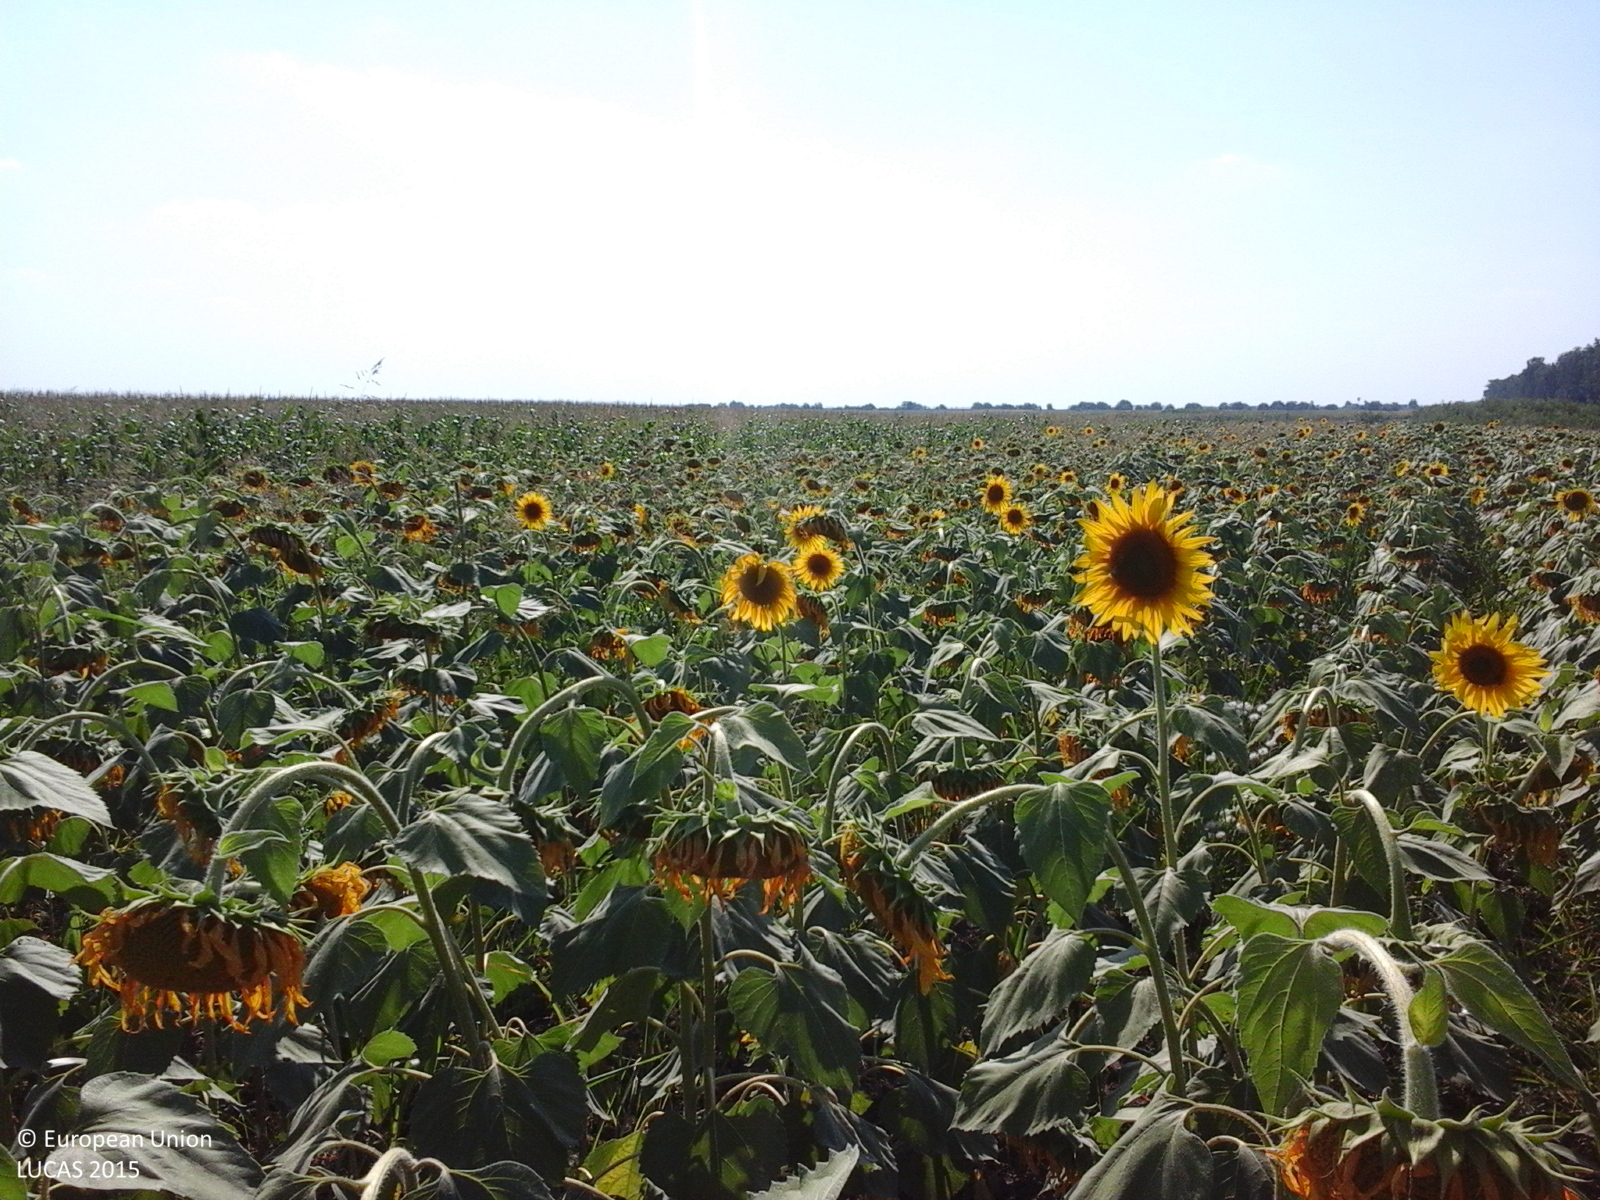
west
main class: Cropland
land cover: Sunflower
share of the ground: > 75 %
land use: Agriculture (excluding fallow land and kitchen gardens)
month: July
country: RO
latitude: 44.8645
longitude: 27.2377
